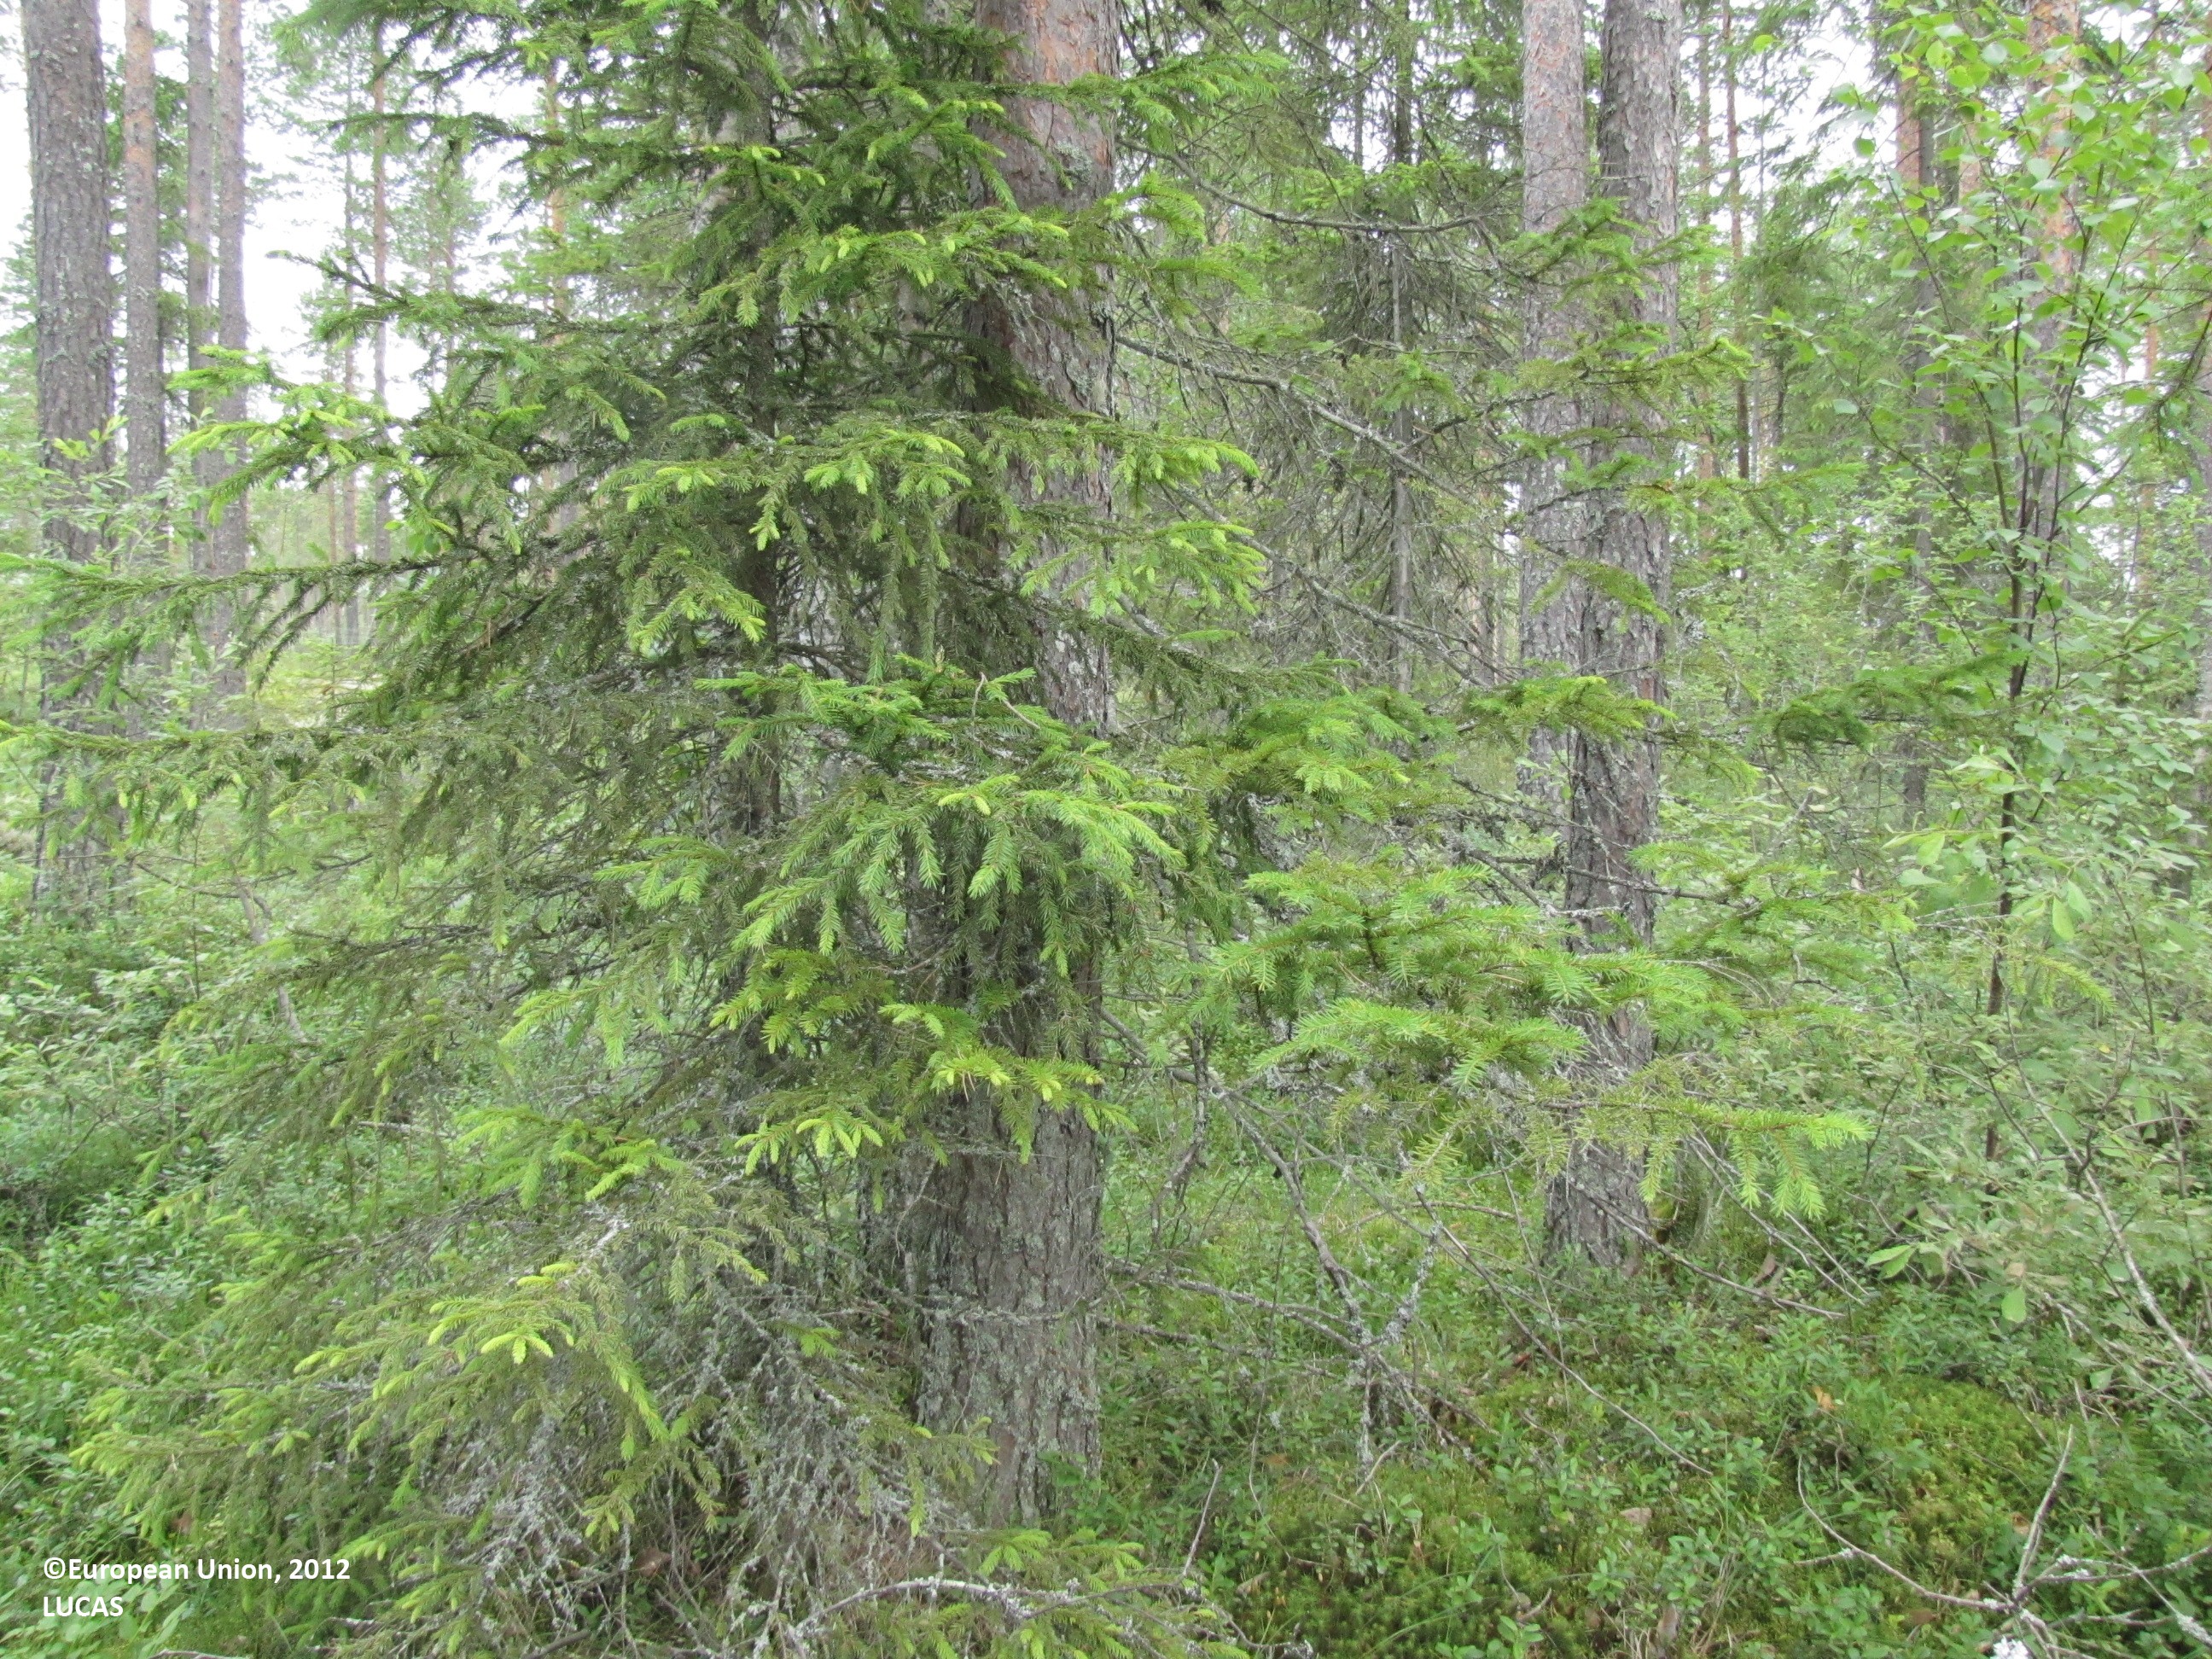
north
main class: Woodland
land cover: Pine dominated coniferous woodland
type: boreal forest
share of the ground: > 75 %
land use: Forestry
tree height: > 5 m
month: July
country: FI
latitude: 62.6631
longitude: 23.4790
